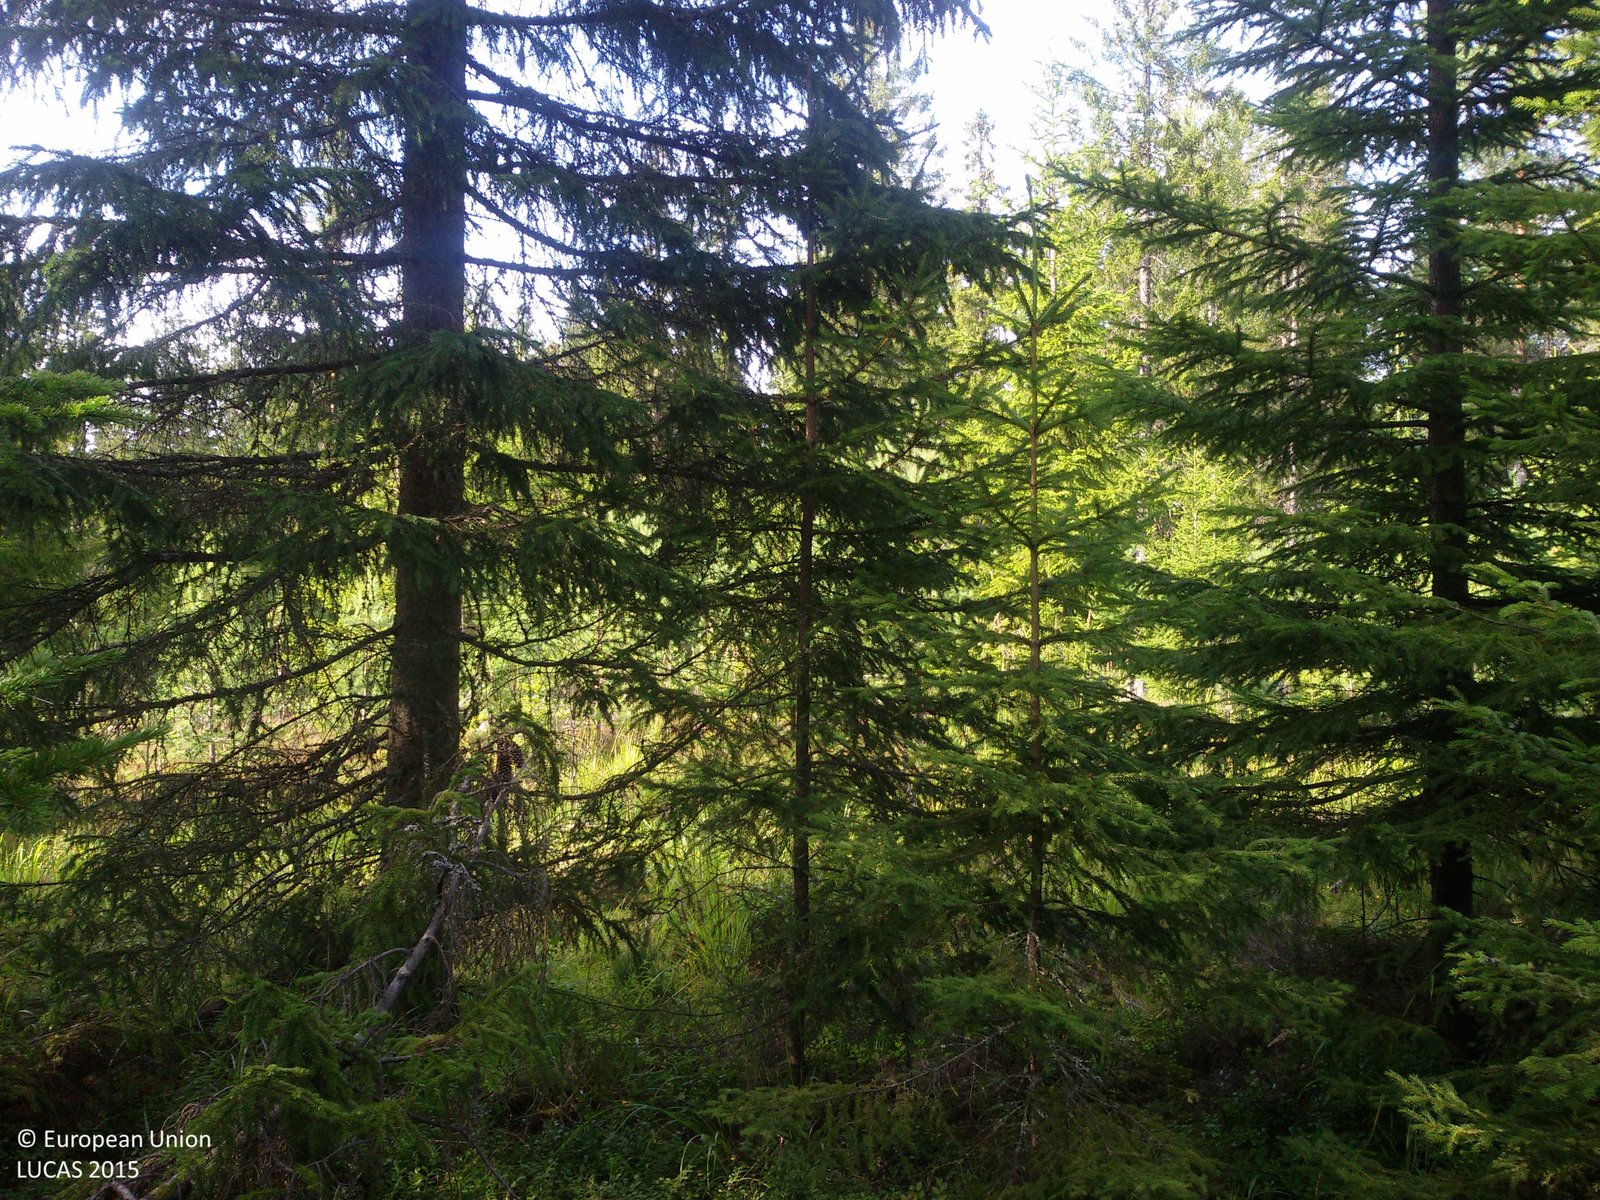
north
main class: Woodland
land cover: Spruce dominated coniferous woodland
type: boreal forest
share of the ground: 50 - 75 %
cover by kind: coniferous forest trees 70 %, lichens and mosses 15 %, shrubs 10 %, herbaceous plants 5 %
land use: Forestry
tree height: > 5 m
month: August
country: SE
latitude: 60.4067
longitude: 16.5787
